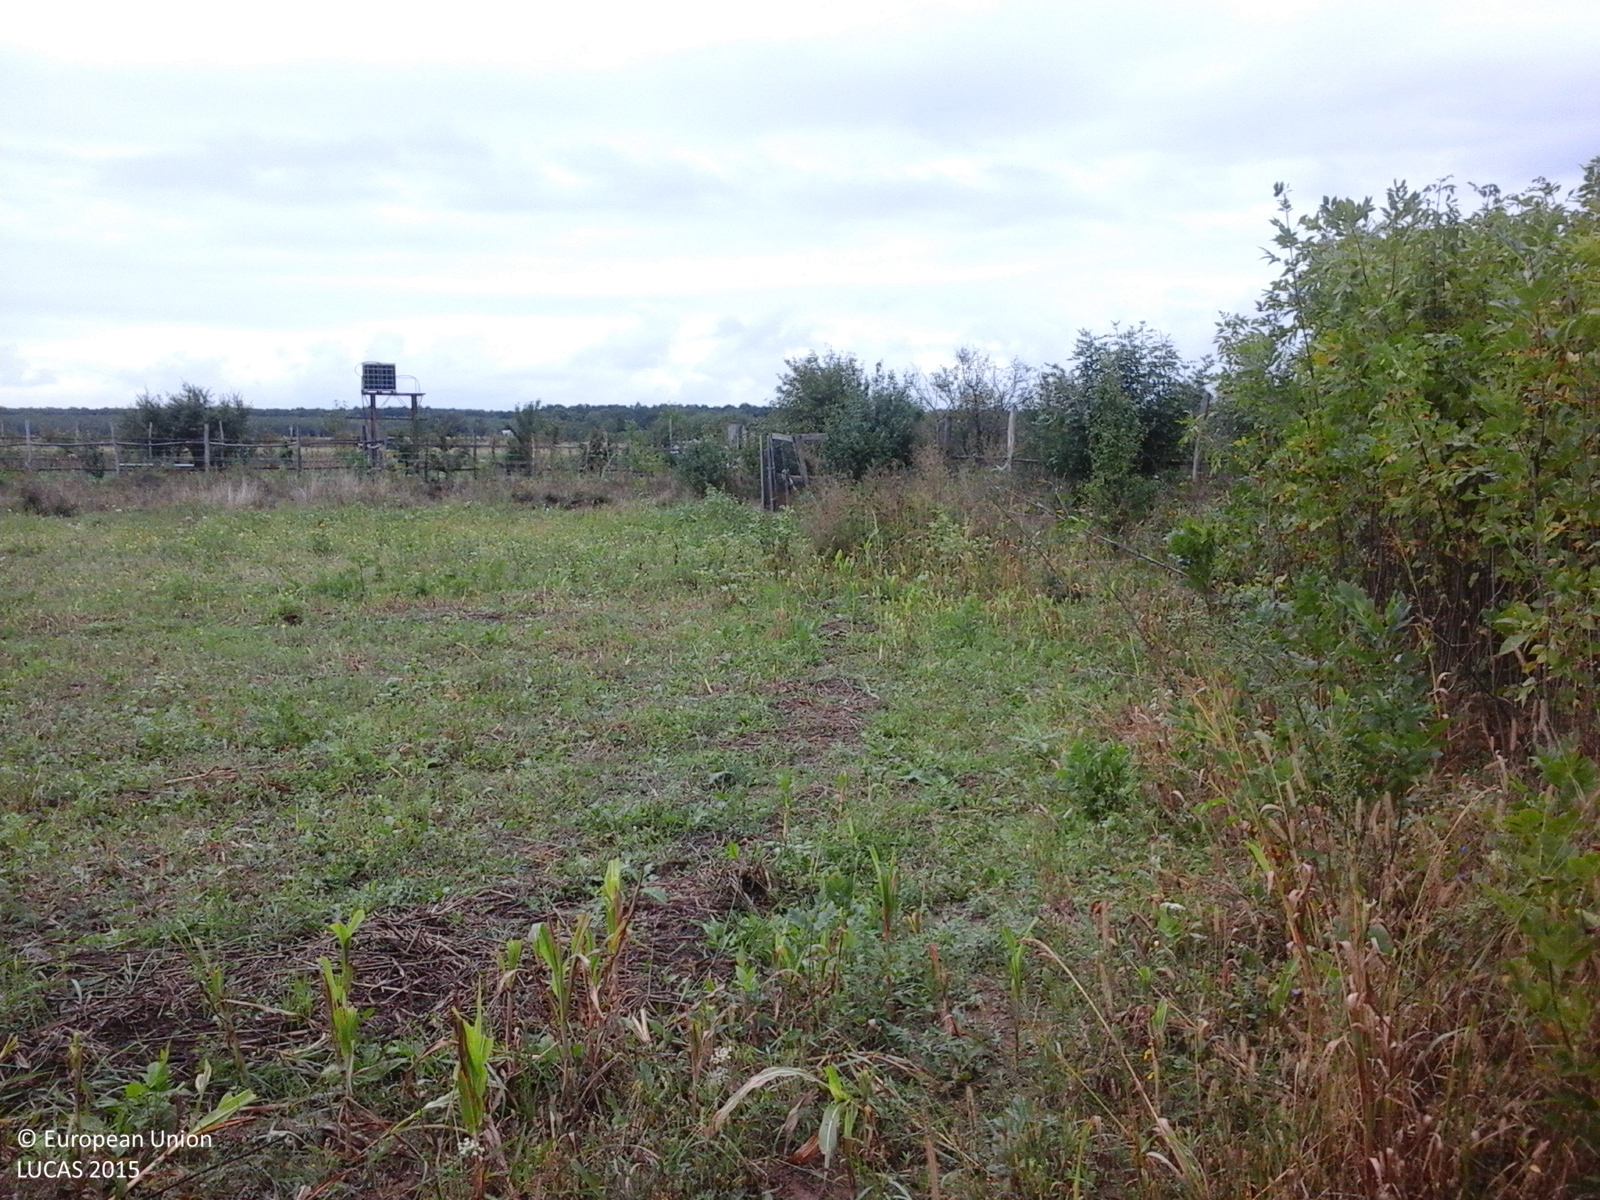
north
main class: Cropland
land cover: Maize
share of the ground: < 10 %
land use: Agriculture (excluding fallow land and kitchen gardens)
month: September
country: RO
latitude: 46.8914
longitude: 21.8433
